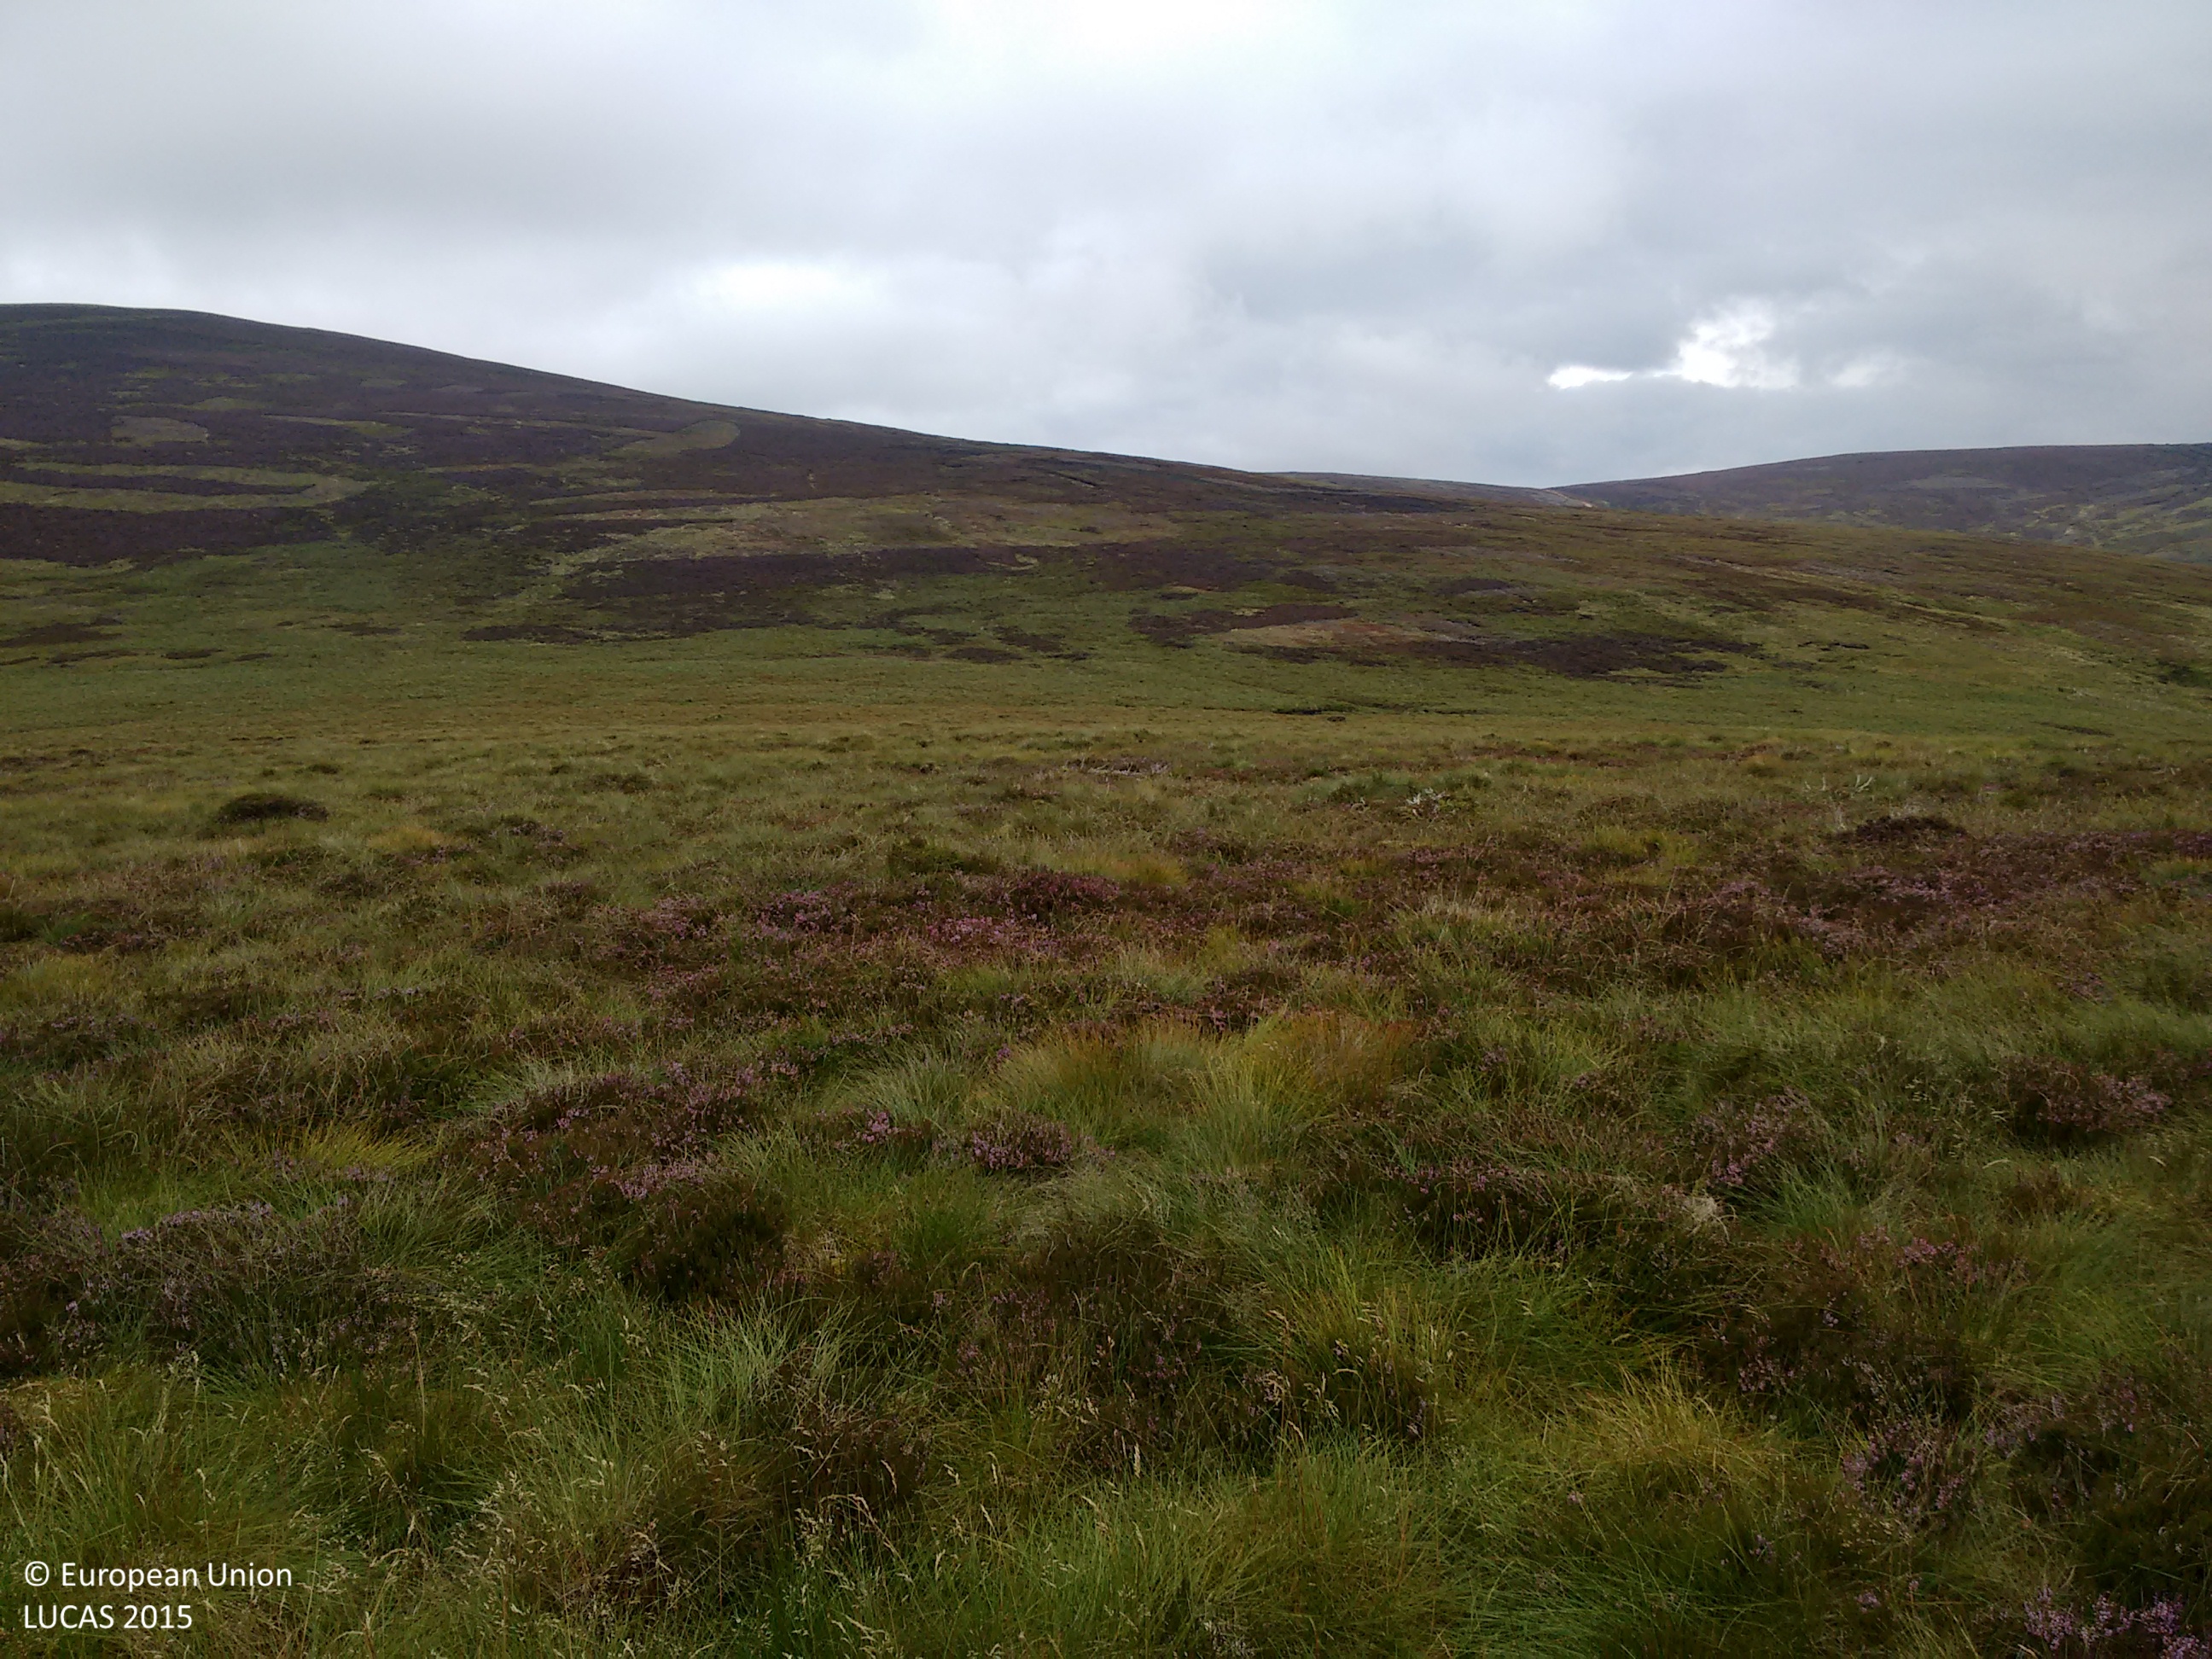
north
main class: Shrubland
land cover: Shrubland without tree cover
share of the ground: > 75 %
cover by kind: shrubs 70 %, herbaceous plants 30 %
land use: Agriculture (excluding fallow land and kitchen gardens)
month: August
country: GB
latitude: 56.9392
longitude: -2.6979
